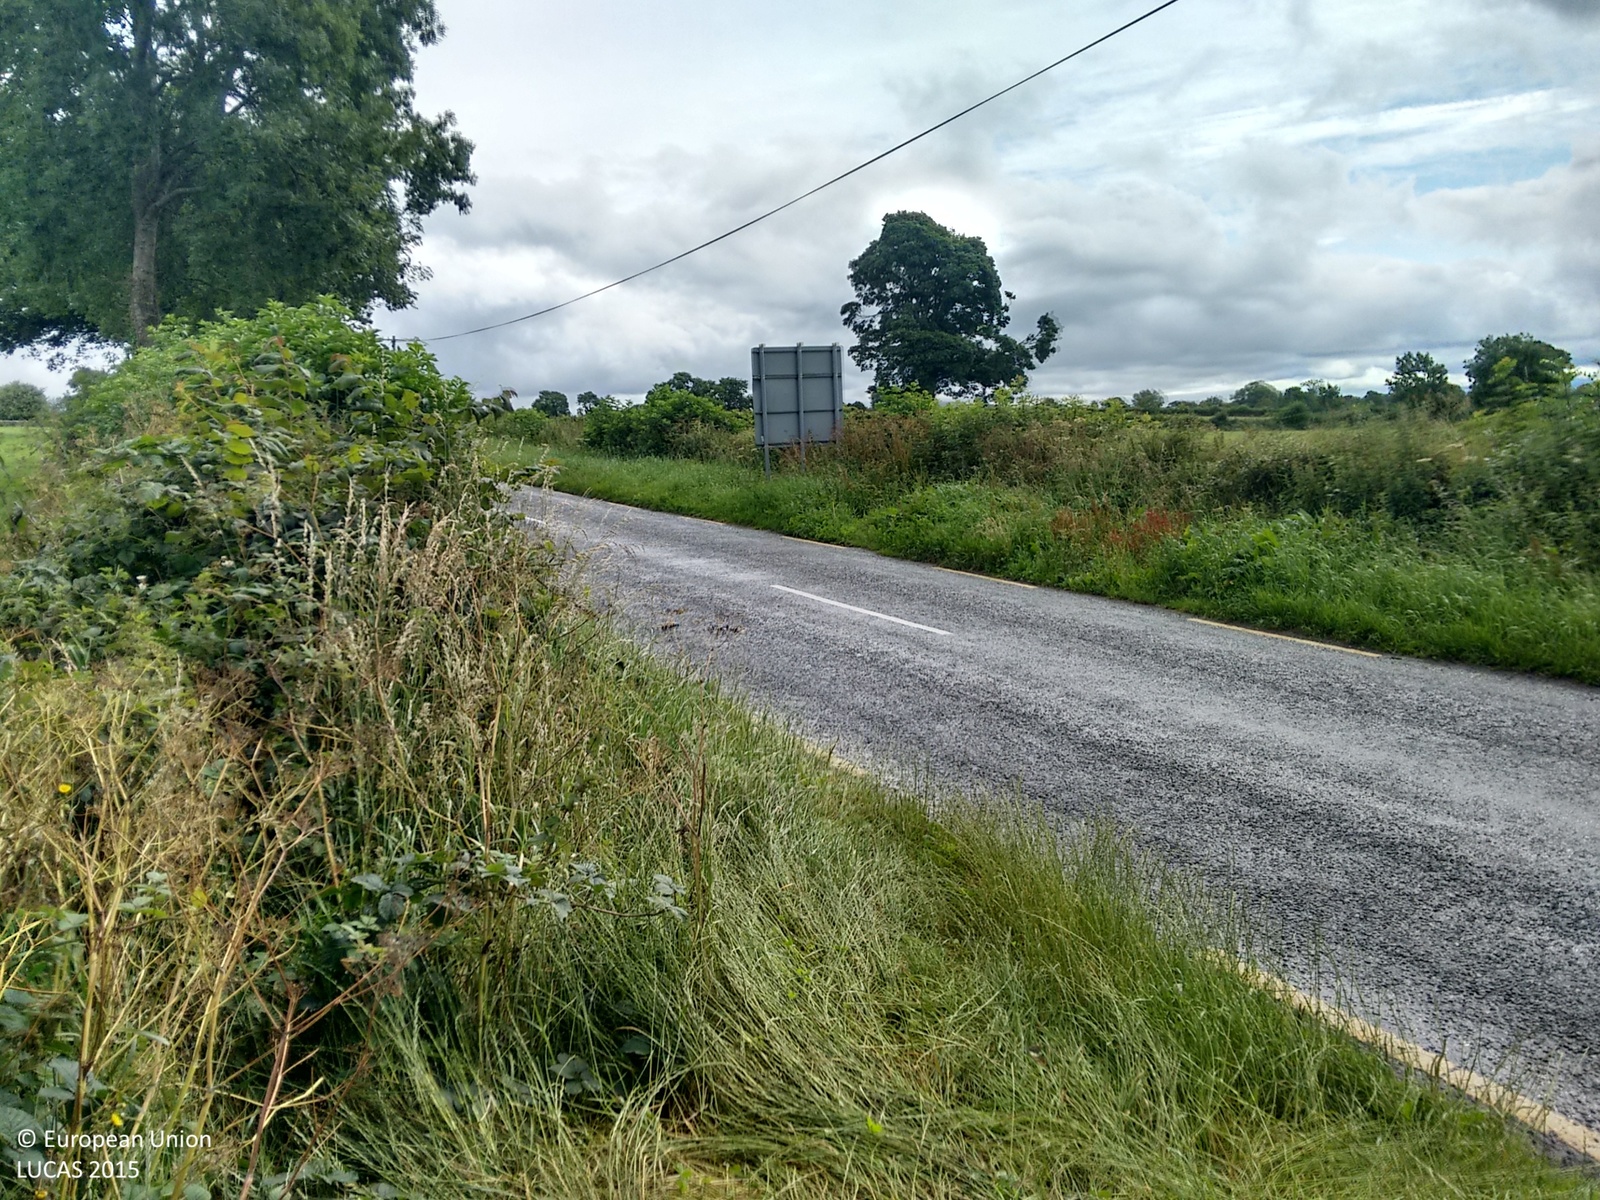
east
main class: Grassland
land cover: Grassland without tree/shrub cover
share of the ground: > 75 %
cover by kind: herbaceous plants 100 %
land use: Agriculture (excluding fallow land and kitchen gardens)
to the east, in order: Grassland without tree/shrub cover; Abandoned hedges; Grassland without tree/shrub cover; Artificial constructions in urban areas; Abandoned hedges; Grassland without tree/shrub cover; Electric lines; Grassland without tree/shrub cover
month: July
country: IE
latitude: 52.6082
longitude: -7.3885
